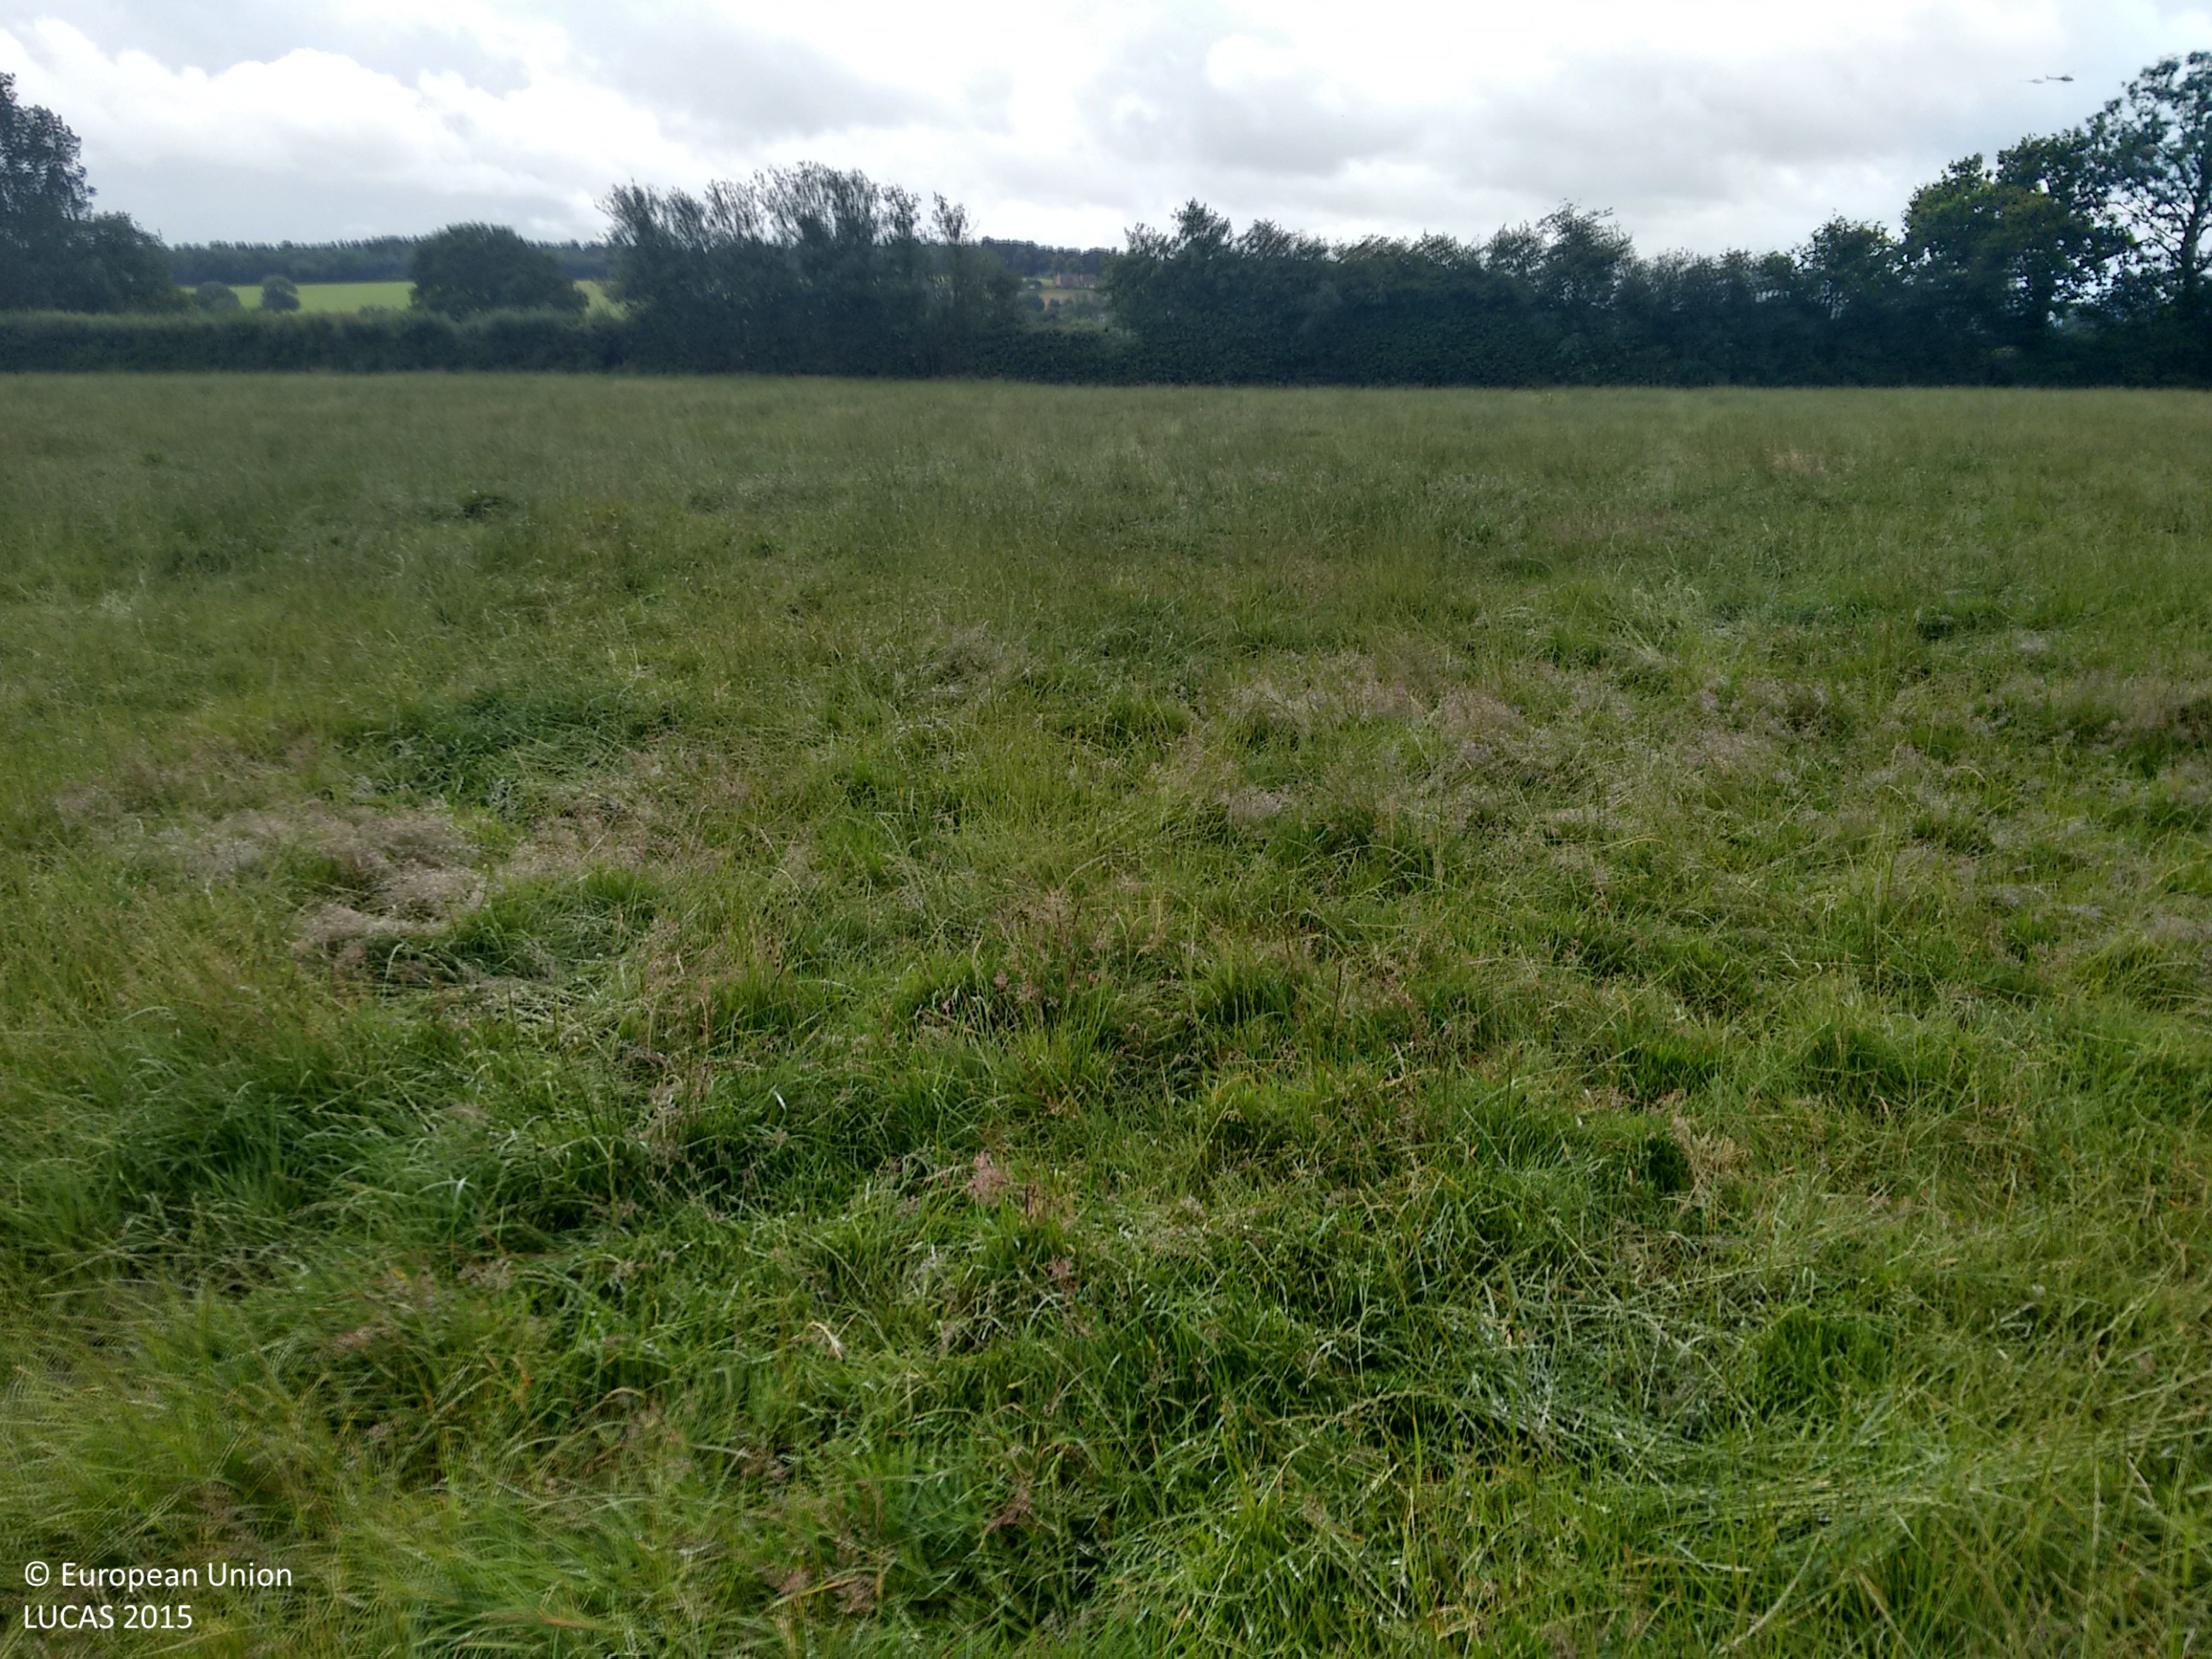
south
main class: Grassland
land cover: Grassland without tree/shrub cover
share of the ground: > 75 %
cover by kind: herbaceous plants 100 %
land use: Agriculture (excluding fallow land and kitchen gardens)
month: July
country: GB
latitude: 52.9672
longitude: -2.3471
